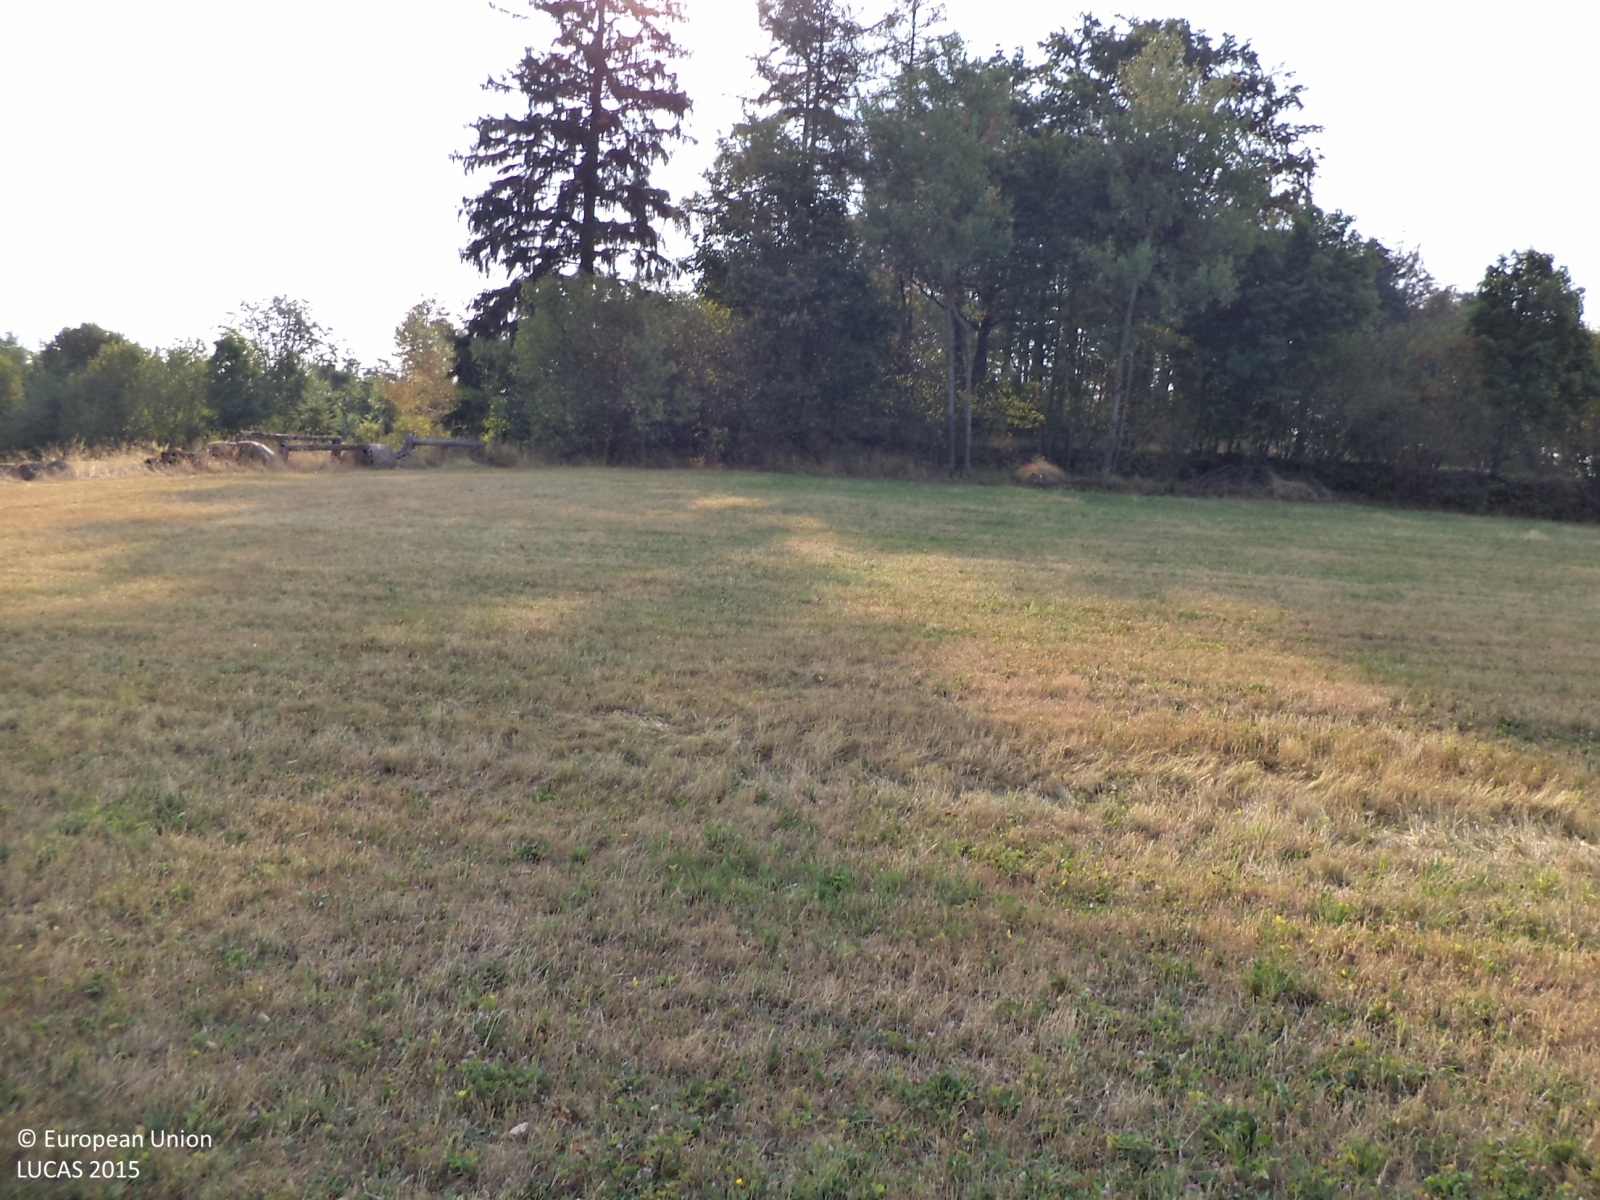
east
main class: Grassland
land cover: Grassland without tree/shrub cover
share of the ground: > 75 %
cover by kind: herbaceous plants 100 %
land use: Agriculture (excluding fallow land and kitchen gardens)
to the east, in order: Grassland without tree/shrub cover; Spontaneously vegetated surfaces; Spruce dominated mixed woodland; Spruce dominated coniferous woodland; Fences; Broadleaved woodland
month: August
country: CZ
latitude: 49.5396
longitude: 14.4373
